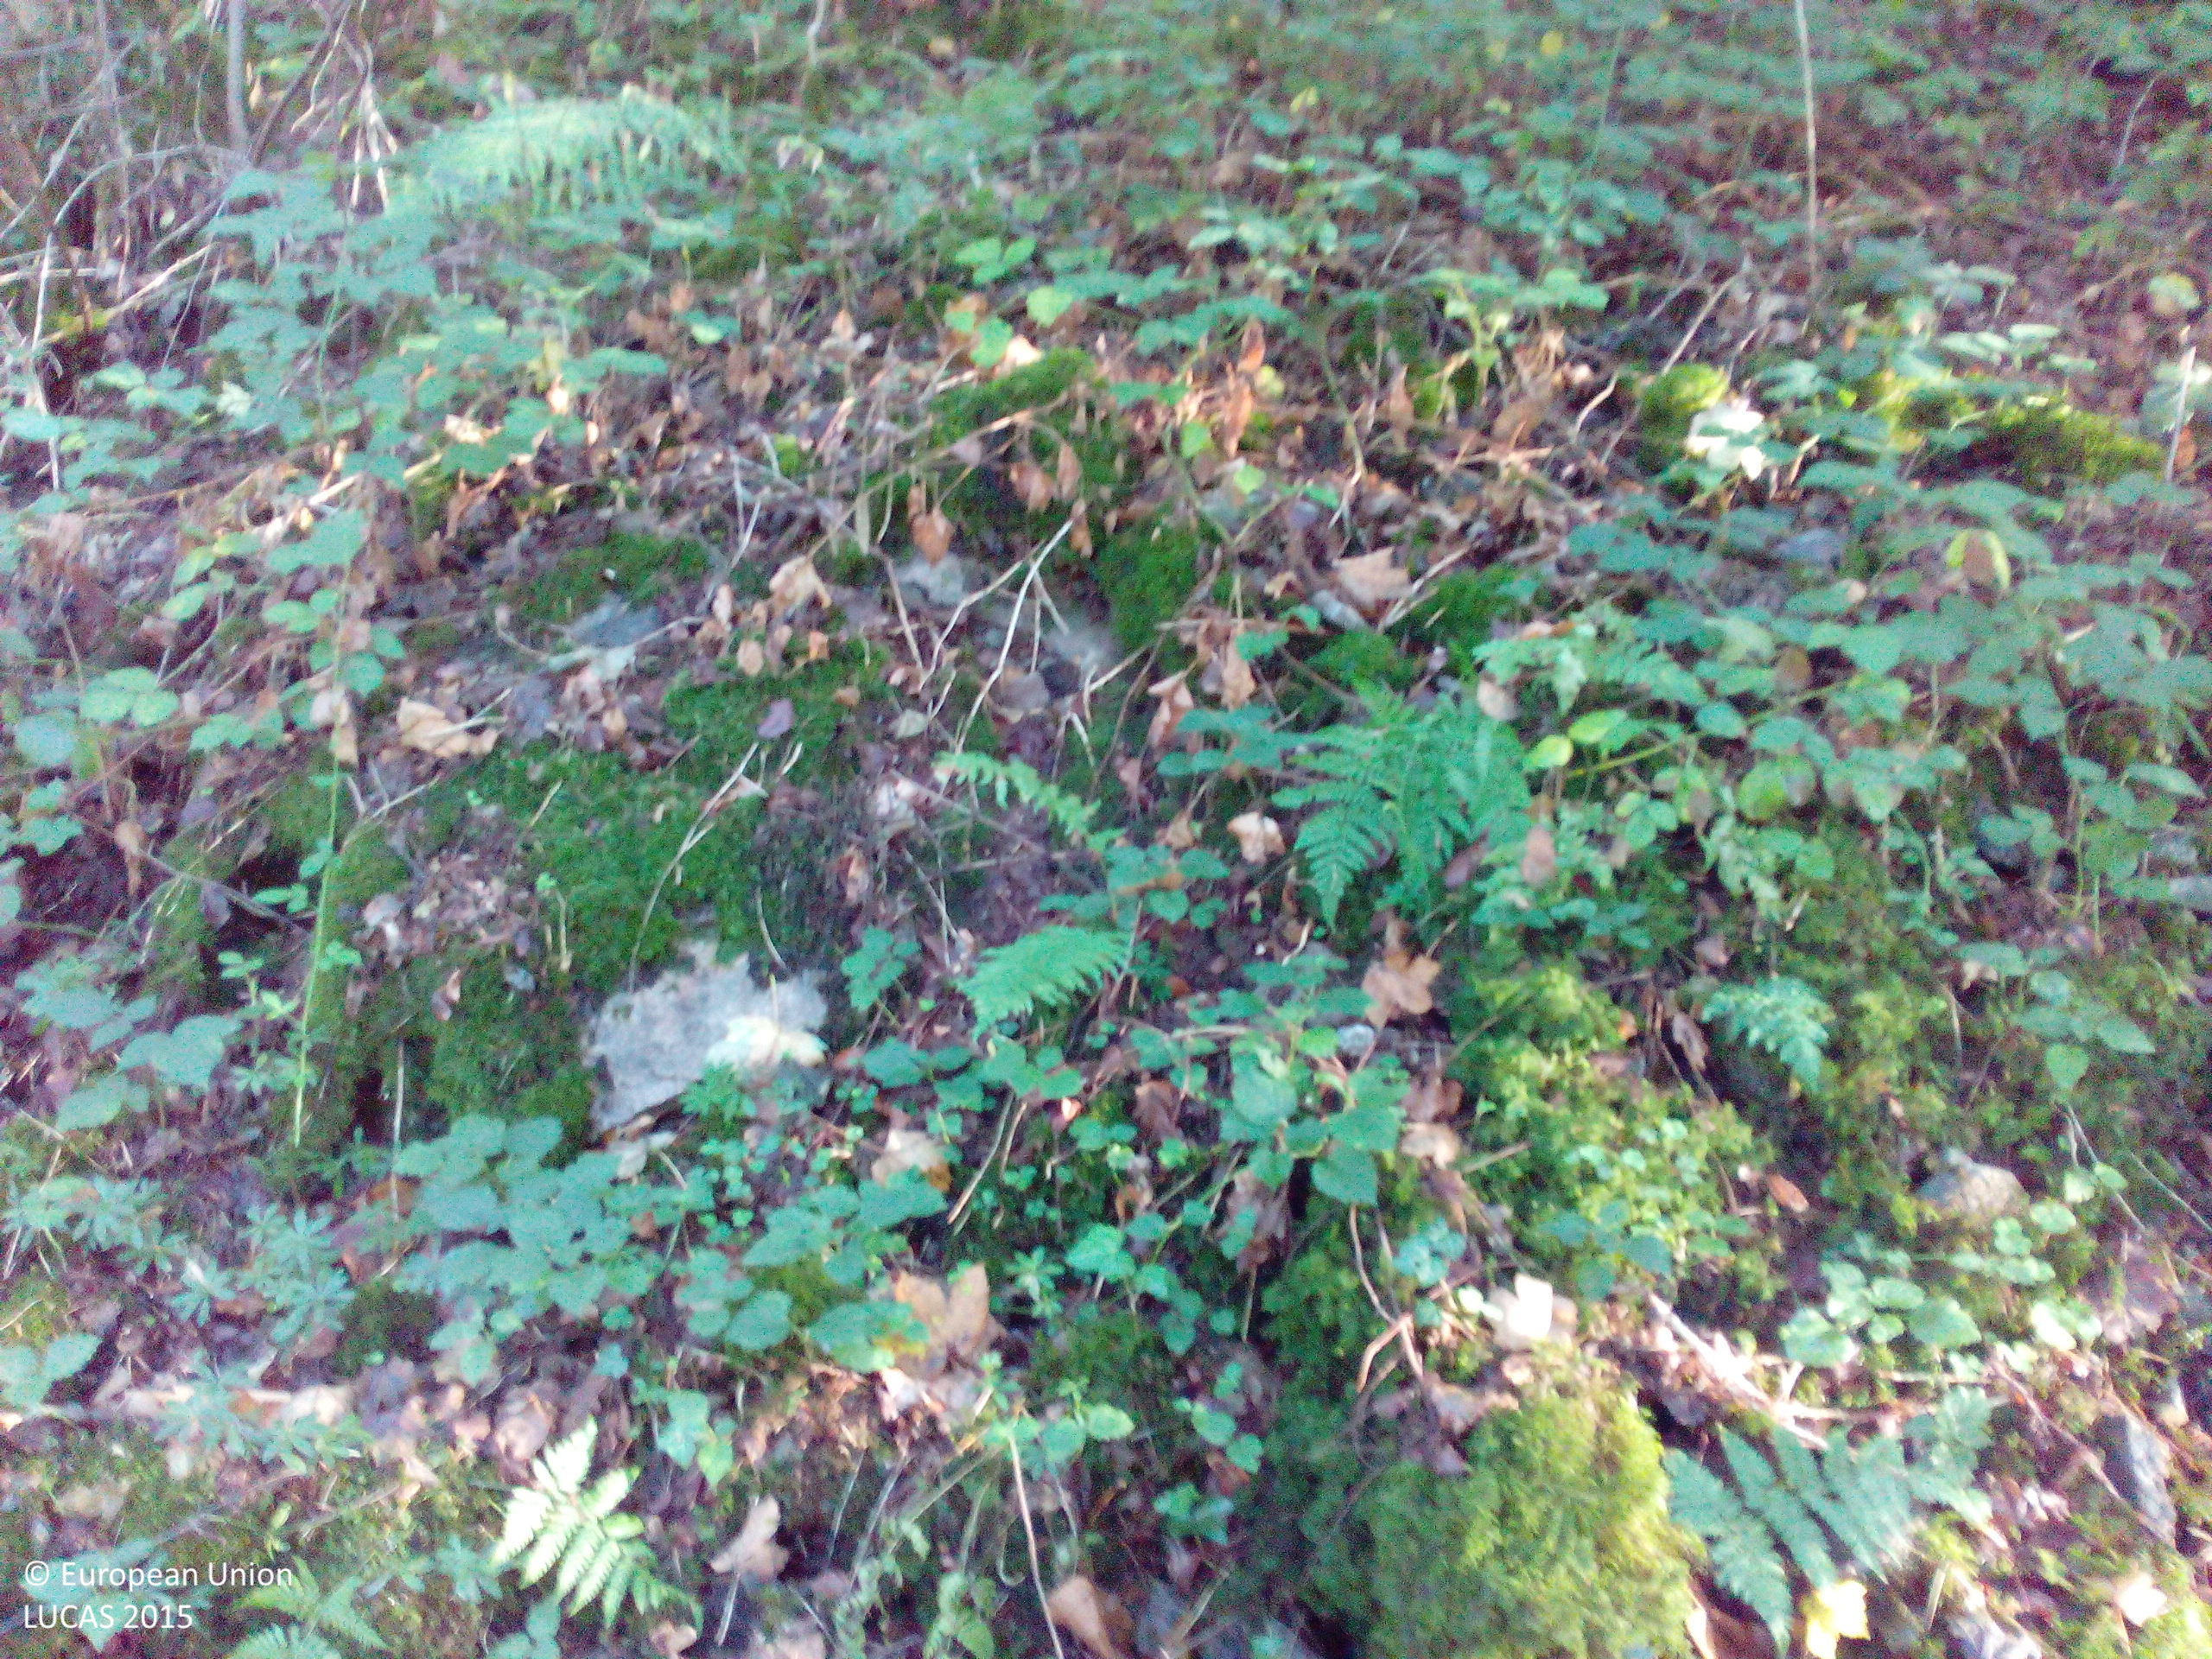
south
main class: Woodland
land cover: Spruce dominated mixed woodland
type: hemiboreal forest and nemoral coniferous forest and mixed broadleaved-coniferous forest
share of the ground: 50 - 75 %
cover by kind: coniferous forest trees 50 %, broadleaved forest trees 20 %, shrubs 10 %, herbaceous plants 10 %, lichens and mosses 10 %
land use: Forestry
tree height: > 5 m
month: September
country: DE
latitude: 48.2796
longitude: 8.1278
